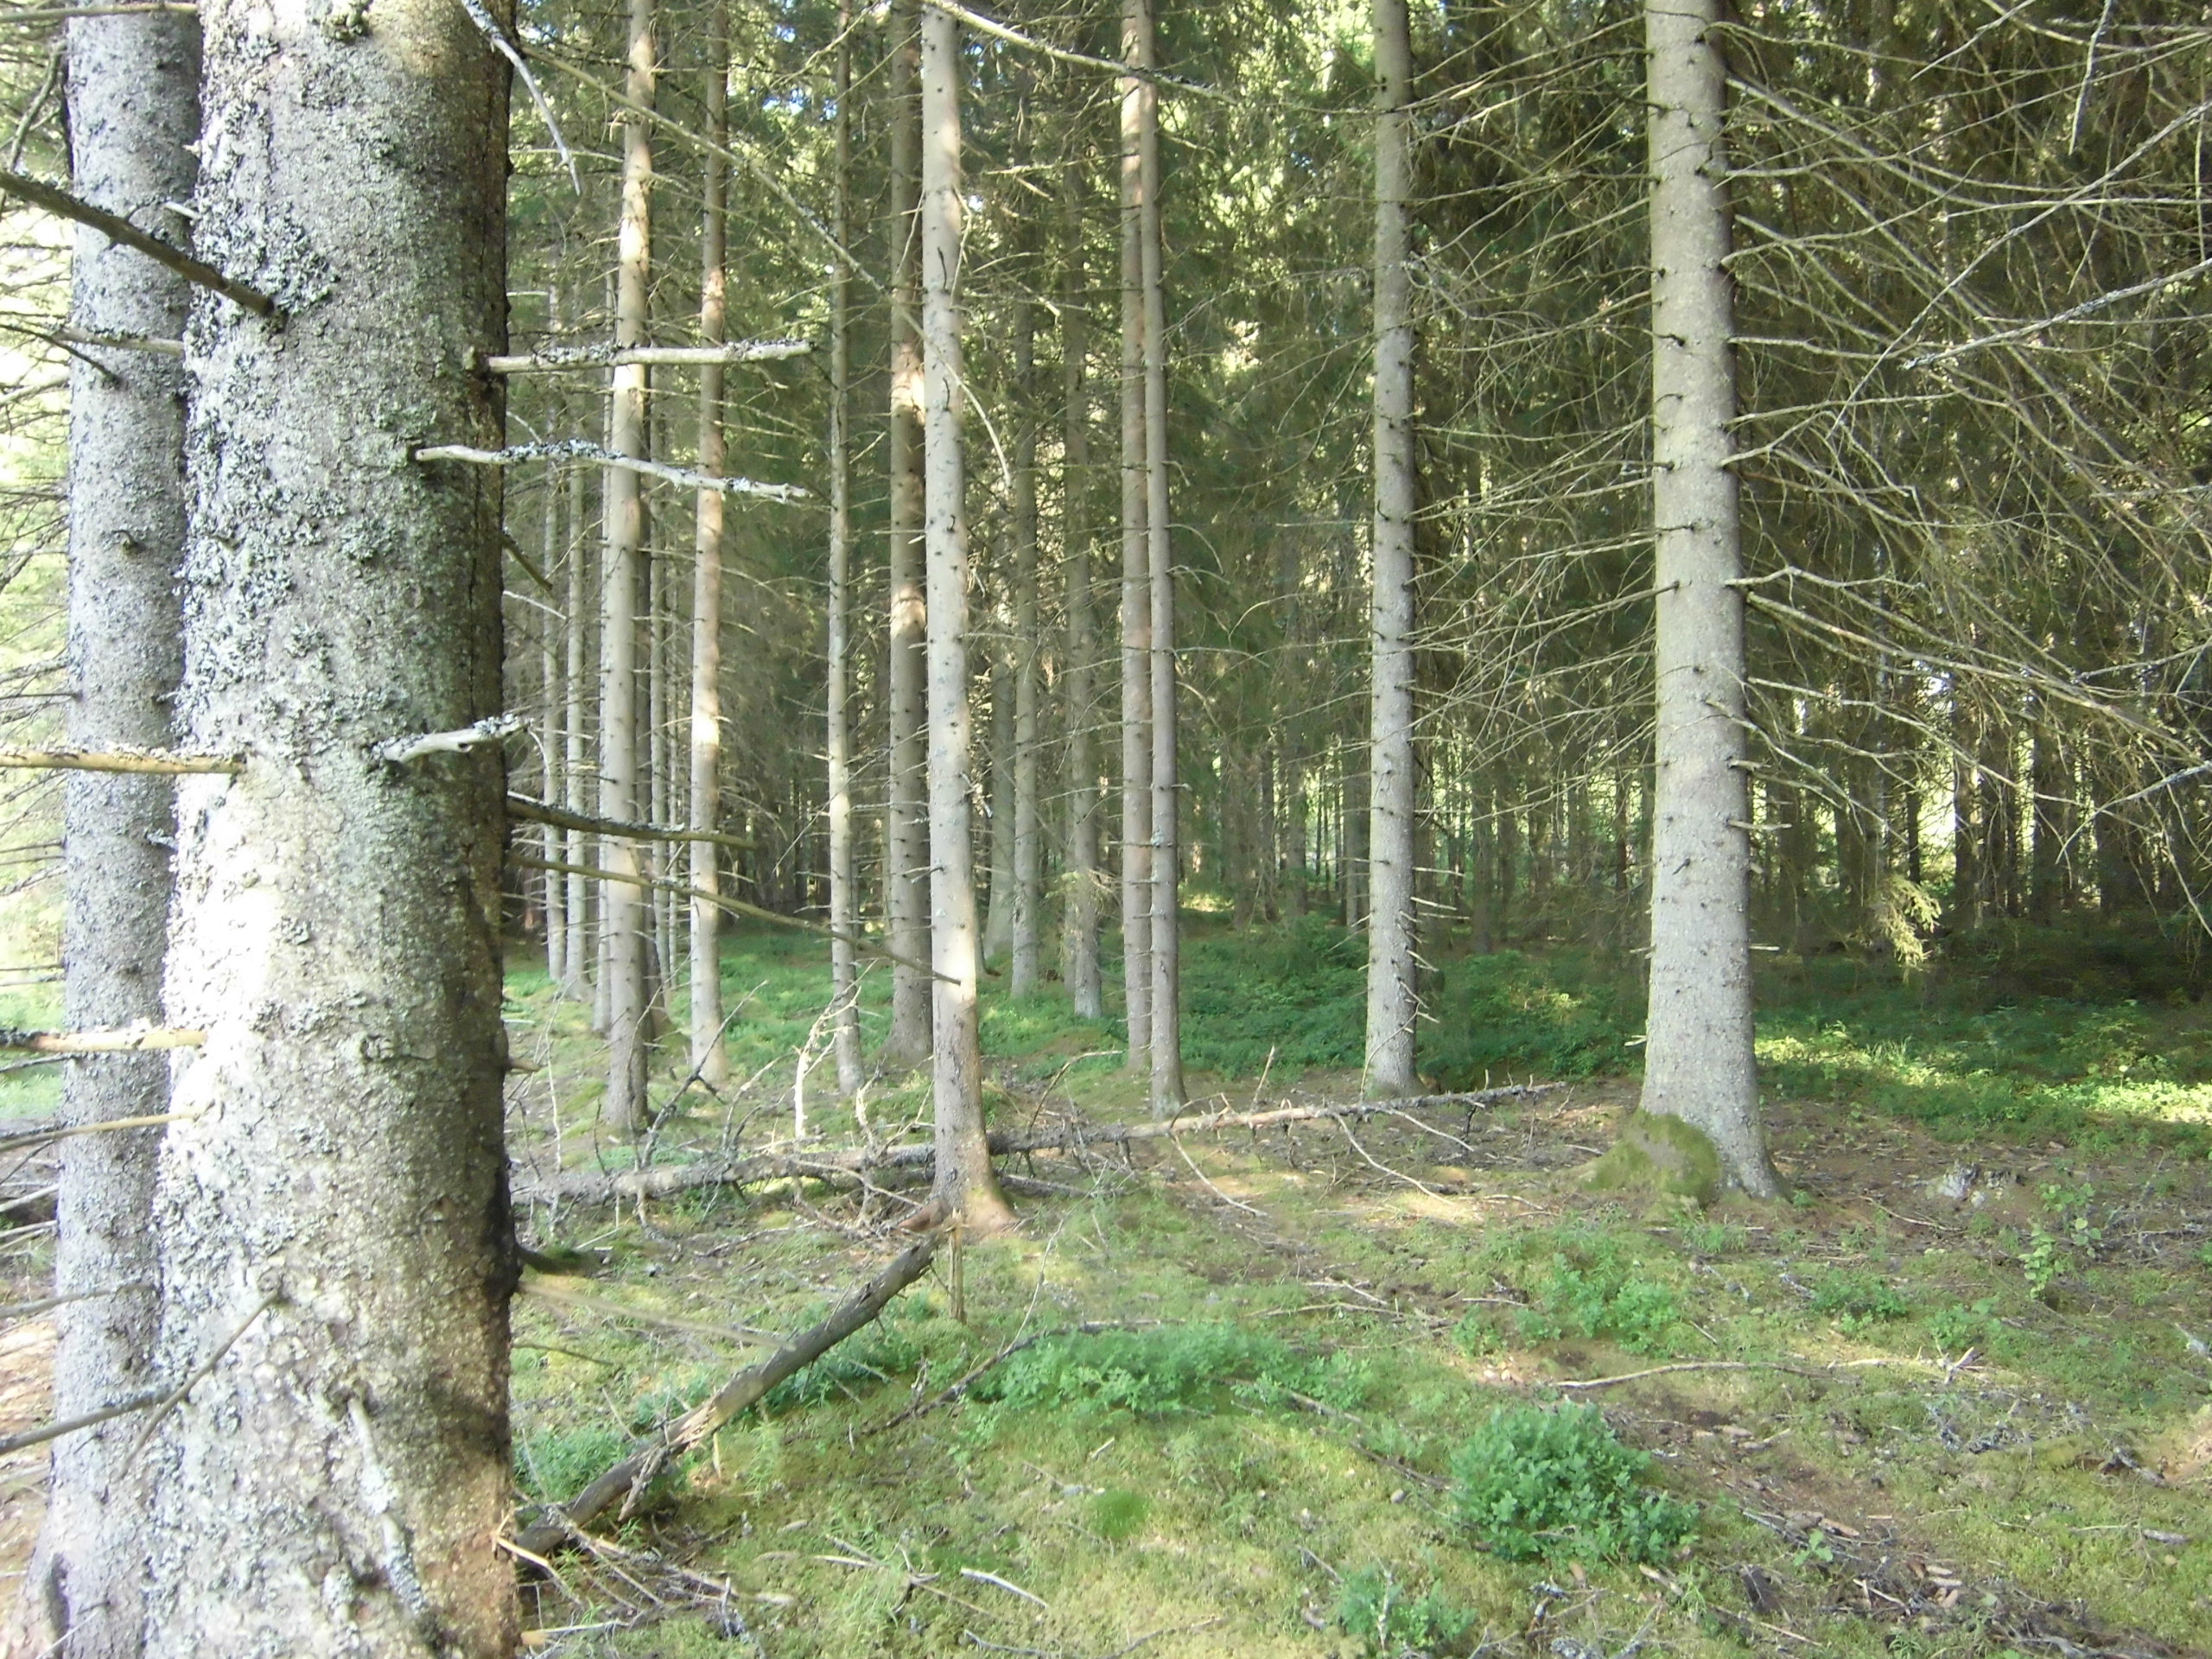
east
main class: Woodland
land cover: Spruce dominated coniferous woodland
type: boreal forest
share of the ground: 50 - 75 %
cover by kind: coniferous forest trees 60 %, shrubs 20 %, herbaceous plants 10 %, lichens and mosses 10 %
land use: Forestry
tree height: > 5 m
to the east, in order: Spruce dominated coniferous woodland; Electric lines; Fences; Grassland with sparse tree/shrub cover; Broadleaved woodland; Electric lines; Broadleaved woodland; Grassland with sparse tree/shrub cover; Fences; Paved roads, cycling and walking lanes; Spruce dominated mixed woodland
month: July
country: SE
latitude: 57.1774
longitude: 15.3070
